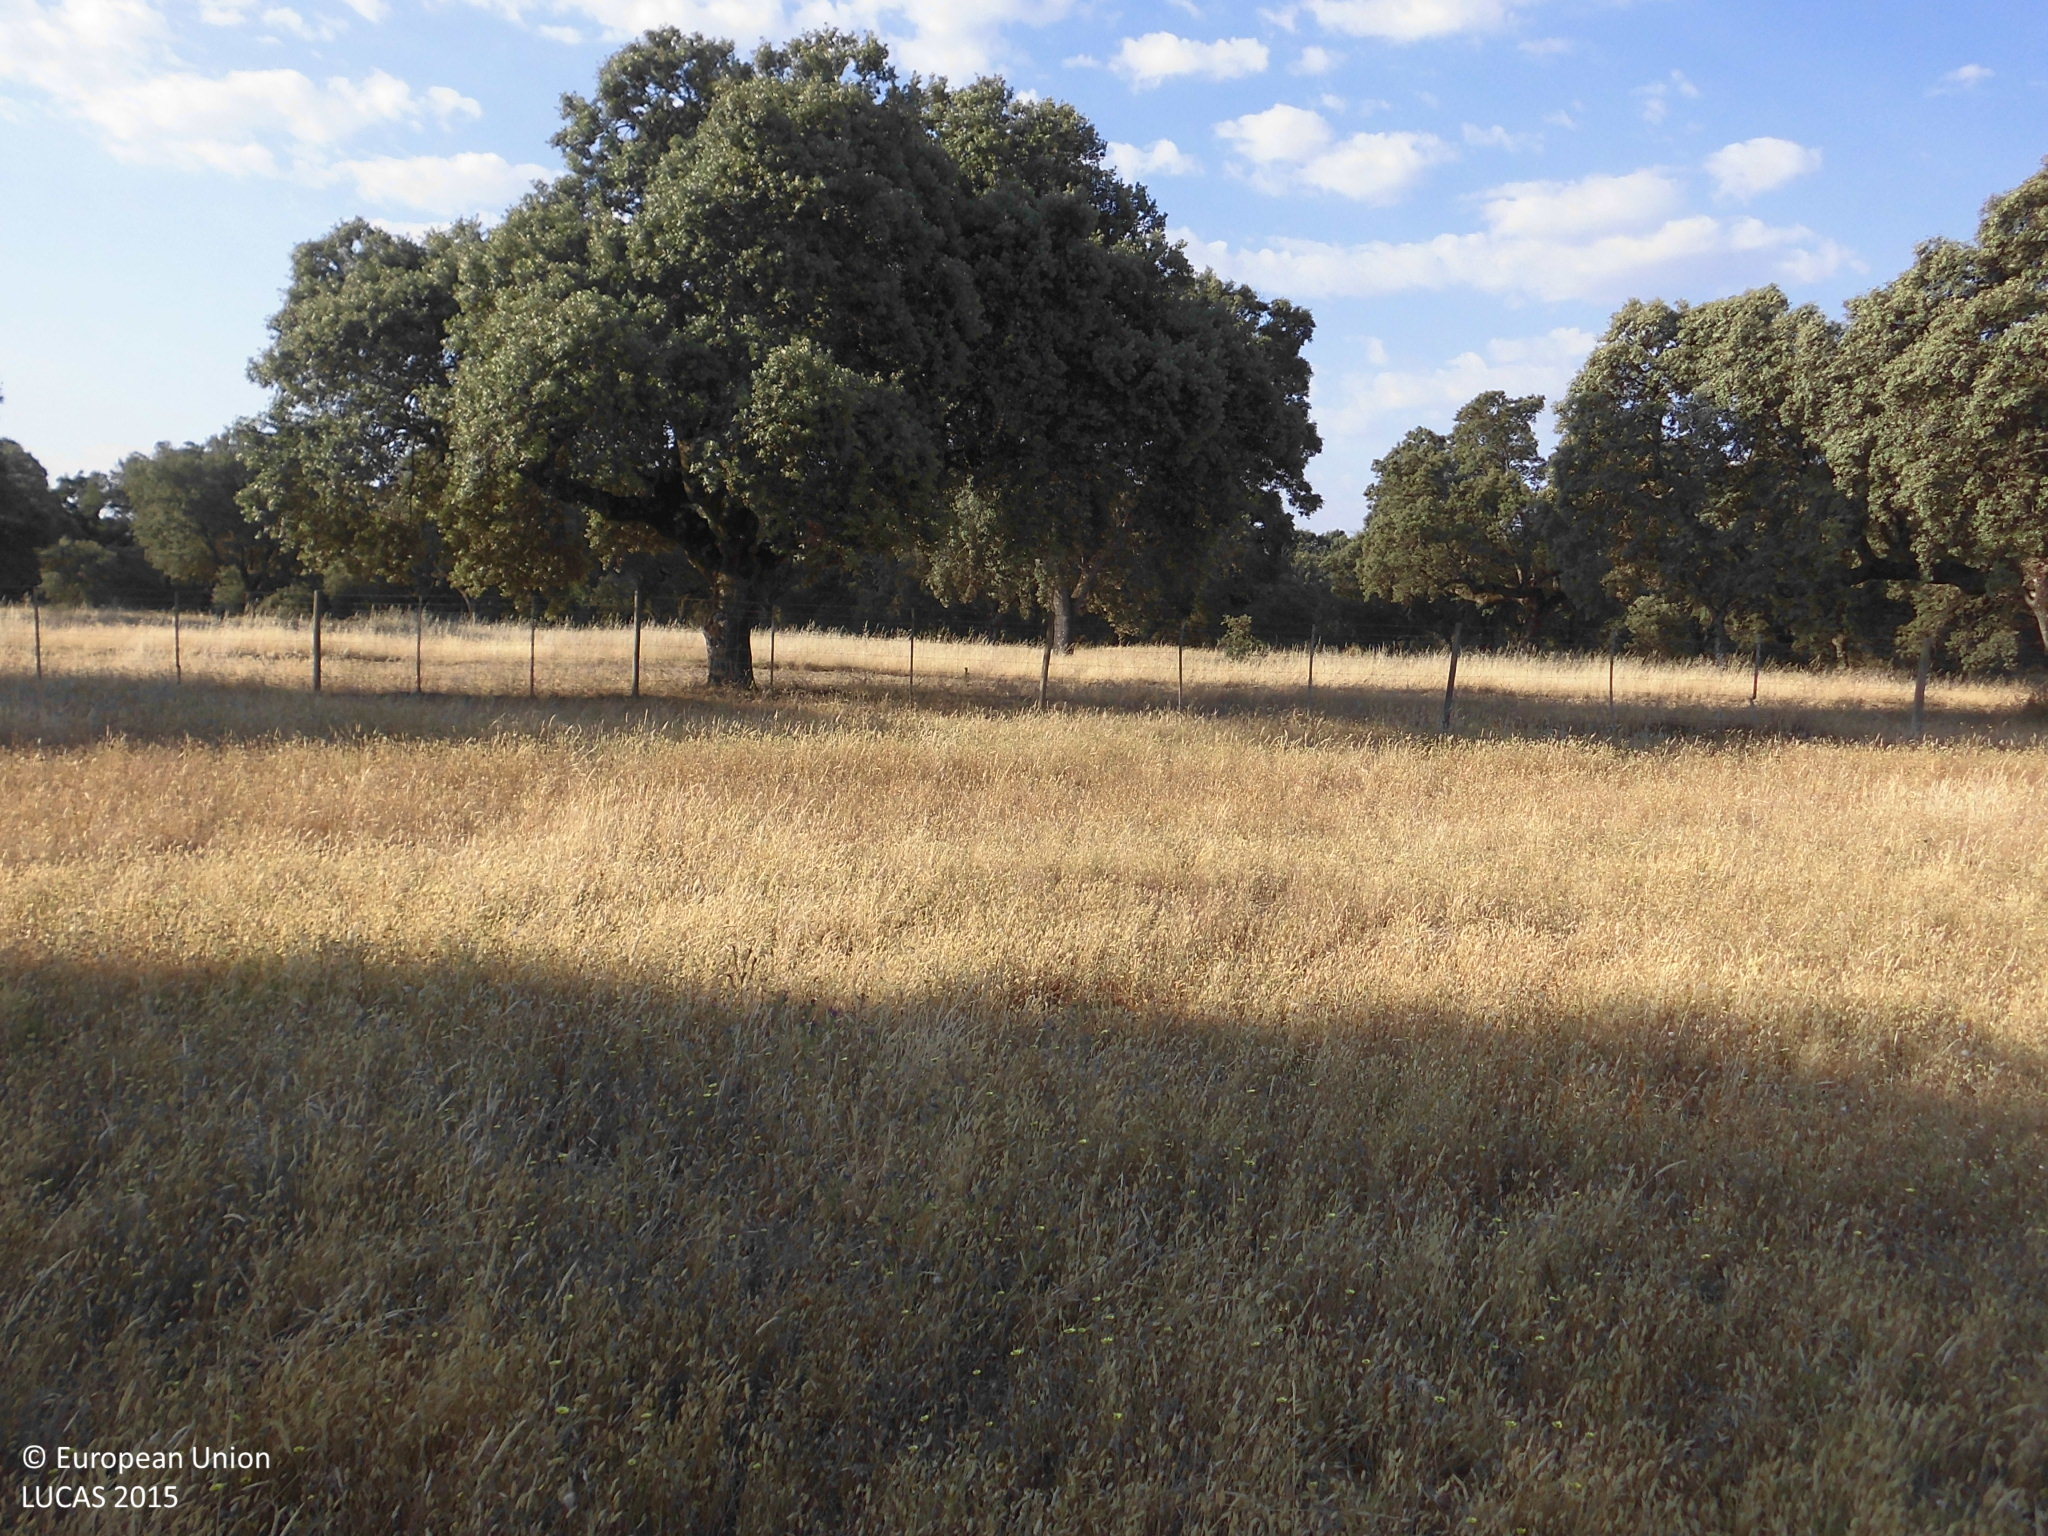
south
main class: Woodland
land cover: Broadleaved woodland
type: broadleaved evergreen forest
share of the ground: 10 - 25 %
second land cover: Grassland without tree/shrub cover
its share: > 75 %
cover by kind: herbaceous plants 80 %, broadleaved forest trees 20 %
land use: Forestry
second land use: Agriculture (excluding fallow land and kitchen gardens)
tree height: > 5 m
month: June
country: ES
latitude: 39.9791
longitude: -5.4093
